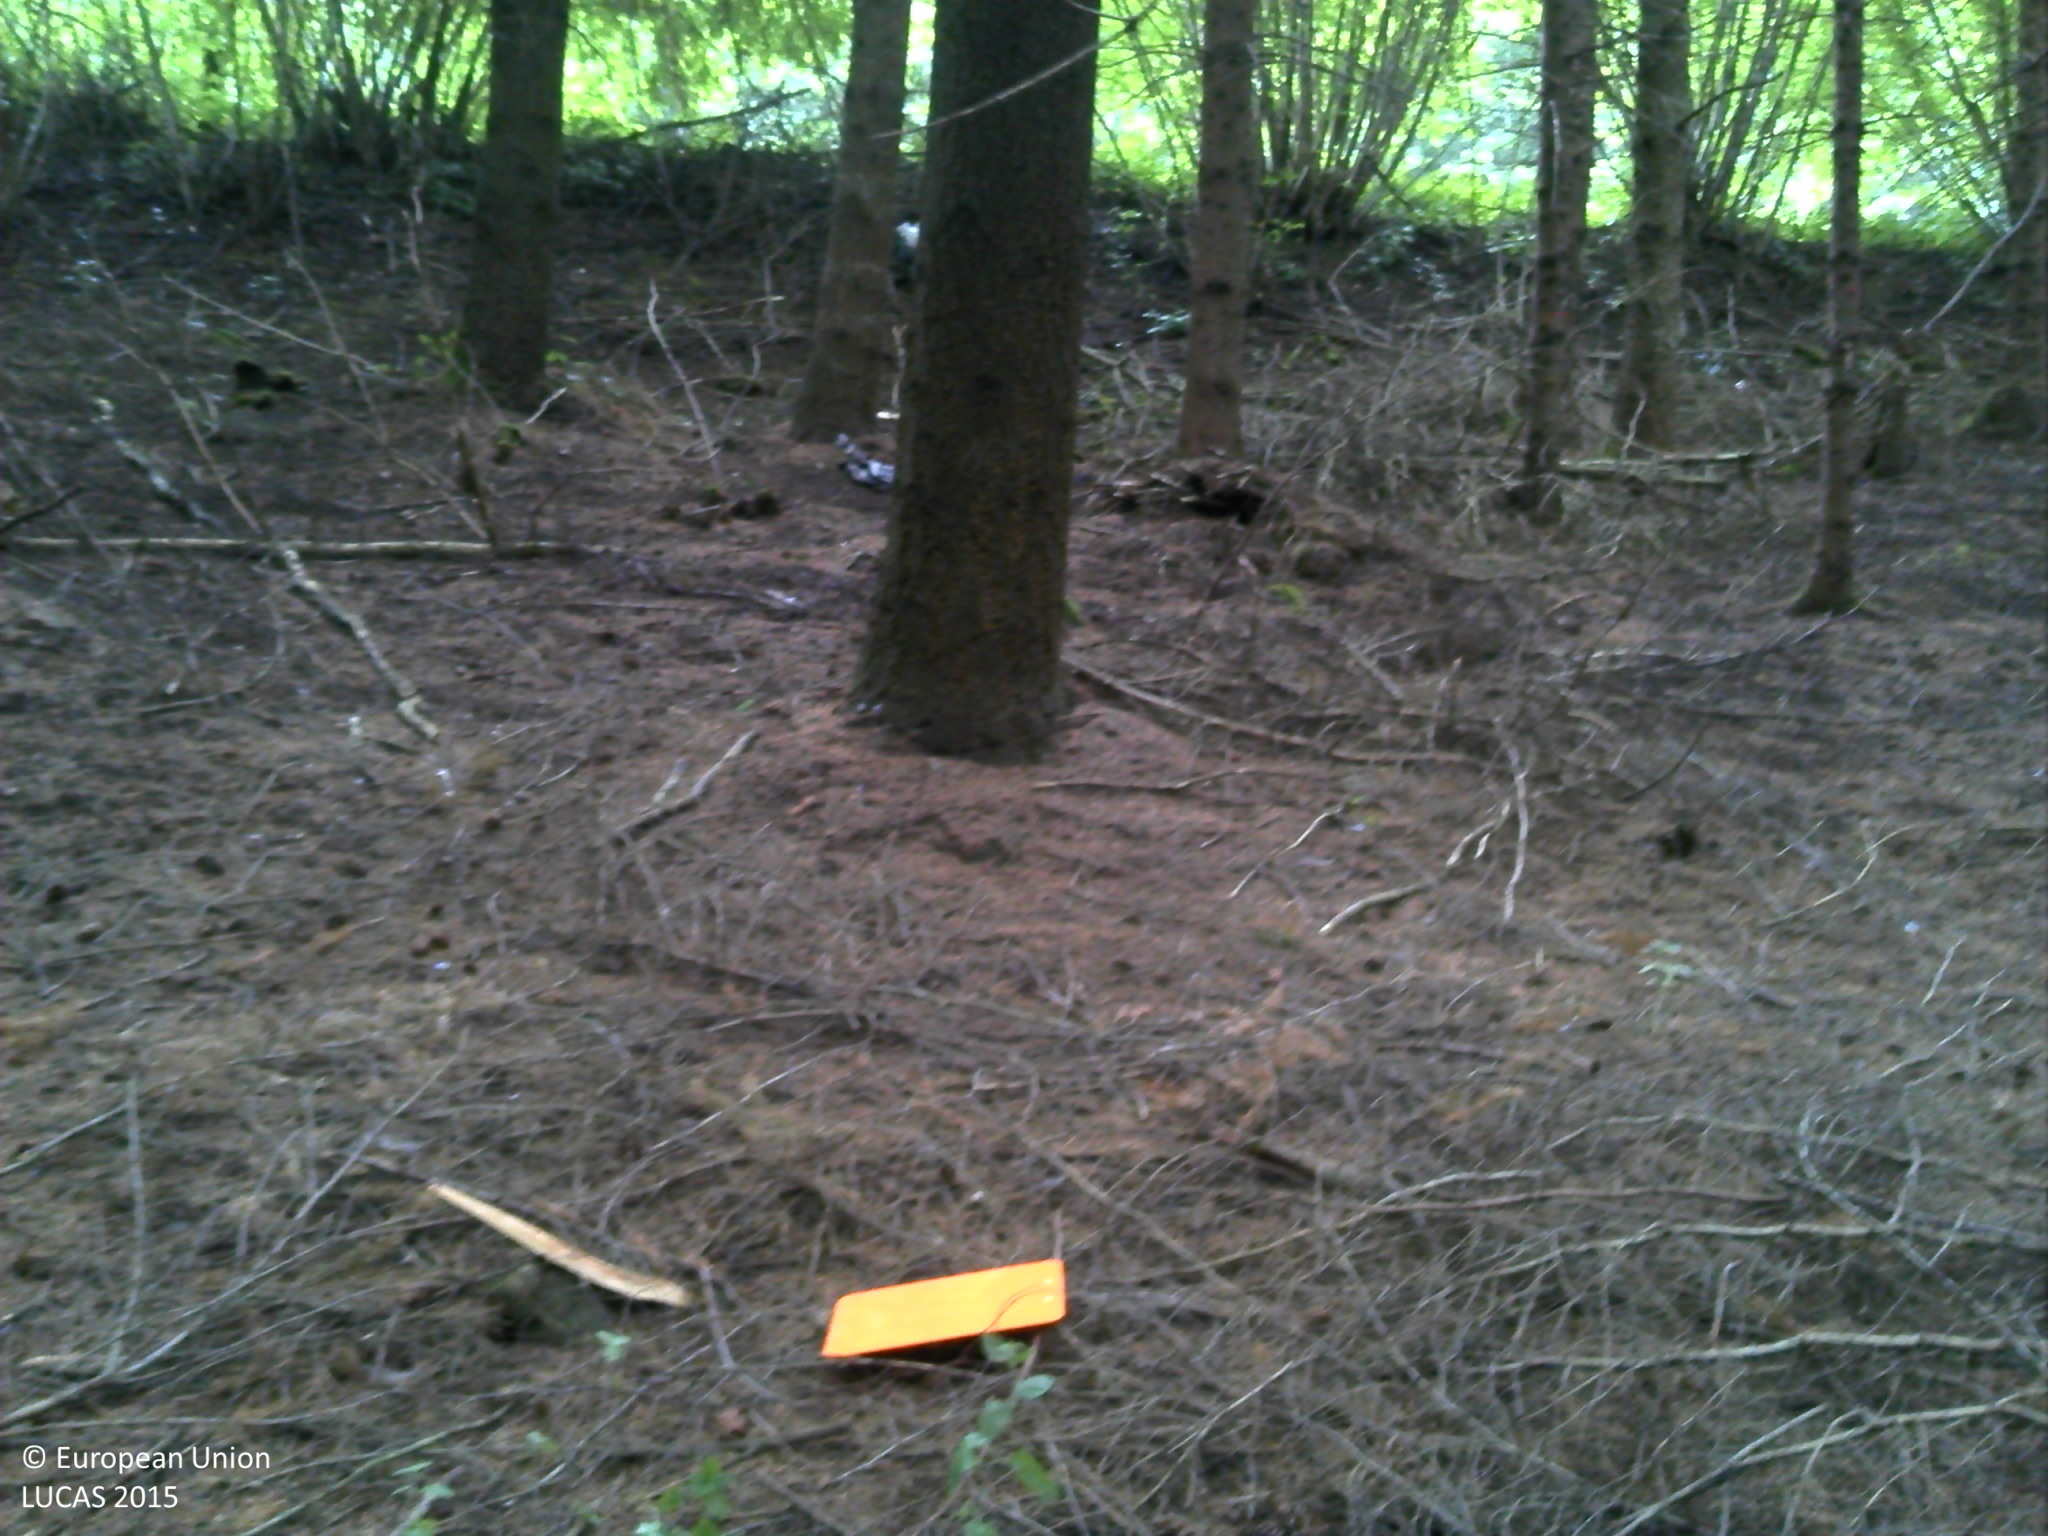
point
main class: Woodland
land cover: Spruce dominated coniferous woodland
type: alpine coniferous forest
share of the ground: > 75 %
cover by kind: coniferous forest trees 80 %, consolidated bare surface 15 %, lichens and mosses 5 %
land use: Forestry
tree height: > 5 m
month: July
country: FR
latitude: 49.7960
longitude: 4.8151
